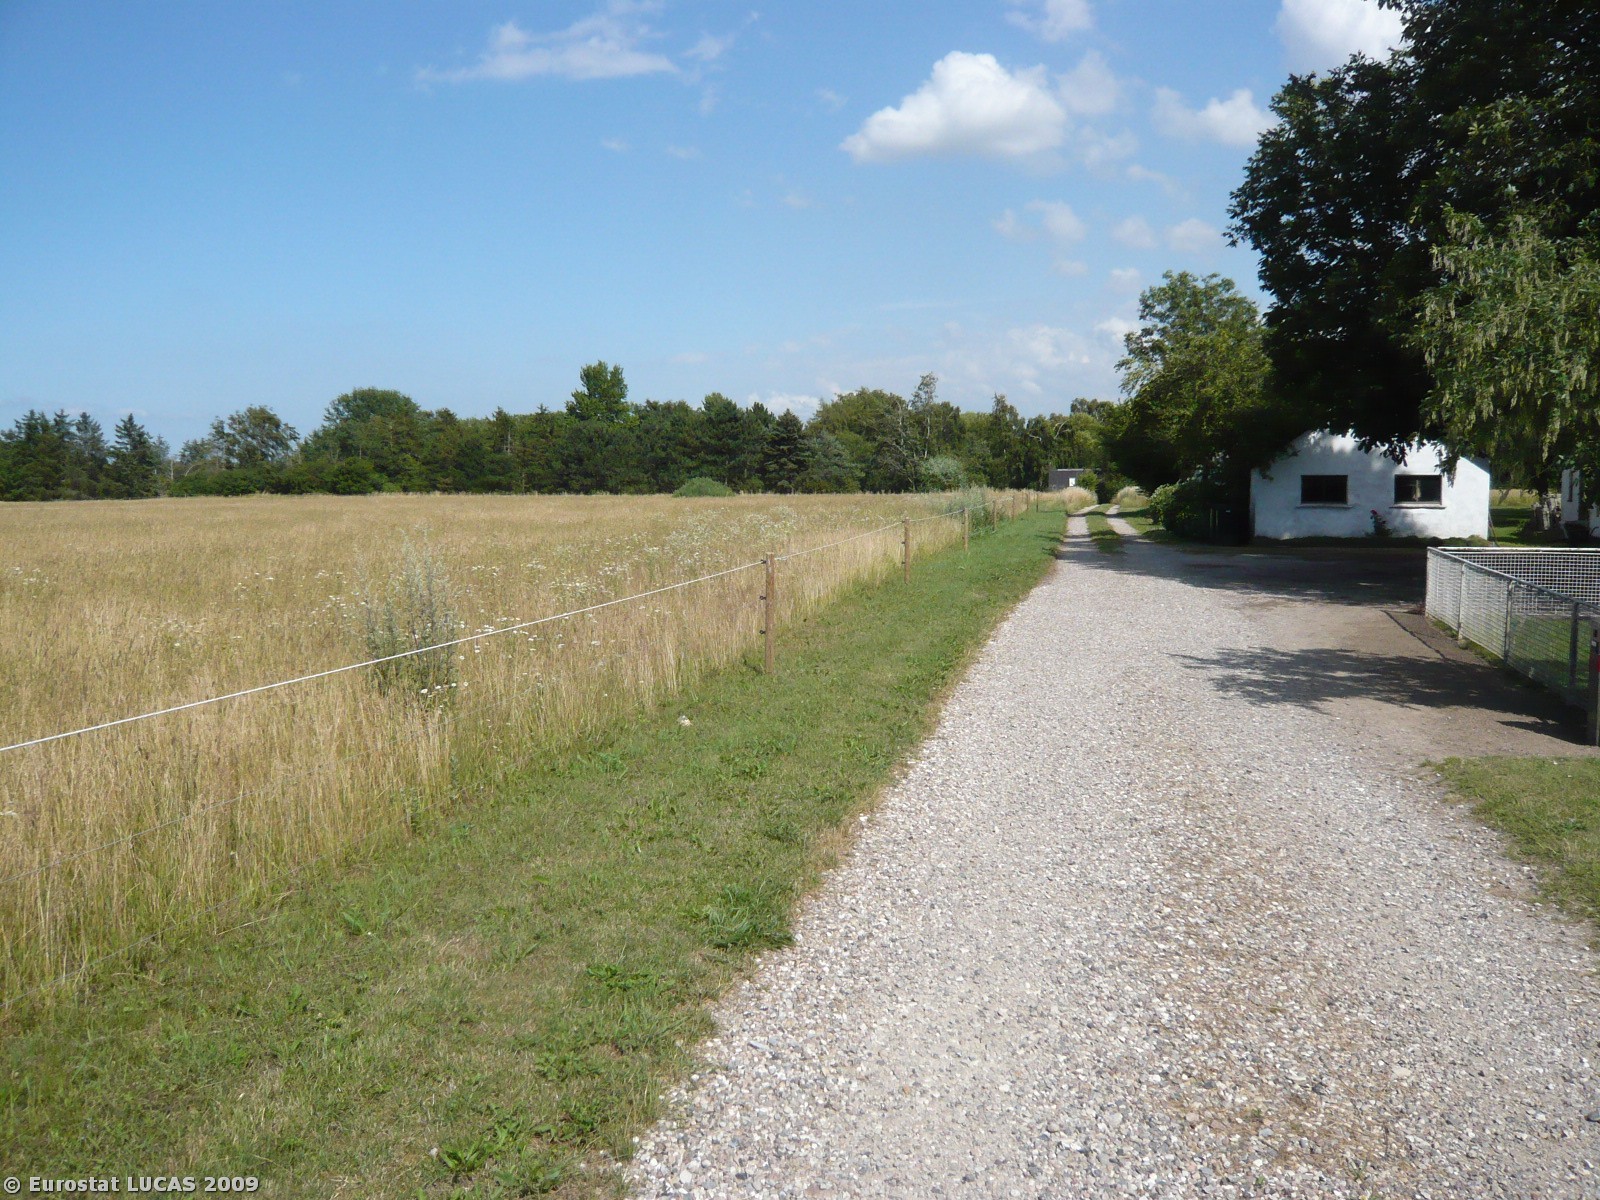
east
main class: Grassland
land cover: Grassland without tree/shrub cover
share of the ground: > 75 %
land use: Agriculture (excluding fallow land and kitchen gardens)
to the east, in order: Grassland without tree/shrub cover; Fences; Broadleaved woodland; Artificial constructions in urban areas
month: July
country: DK
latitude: 55.7625
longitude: 11.7355
